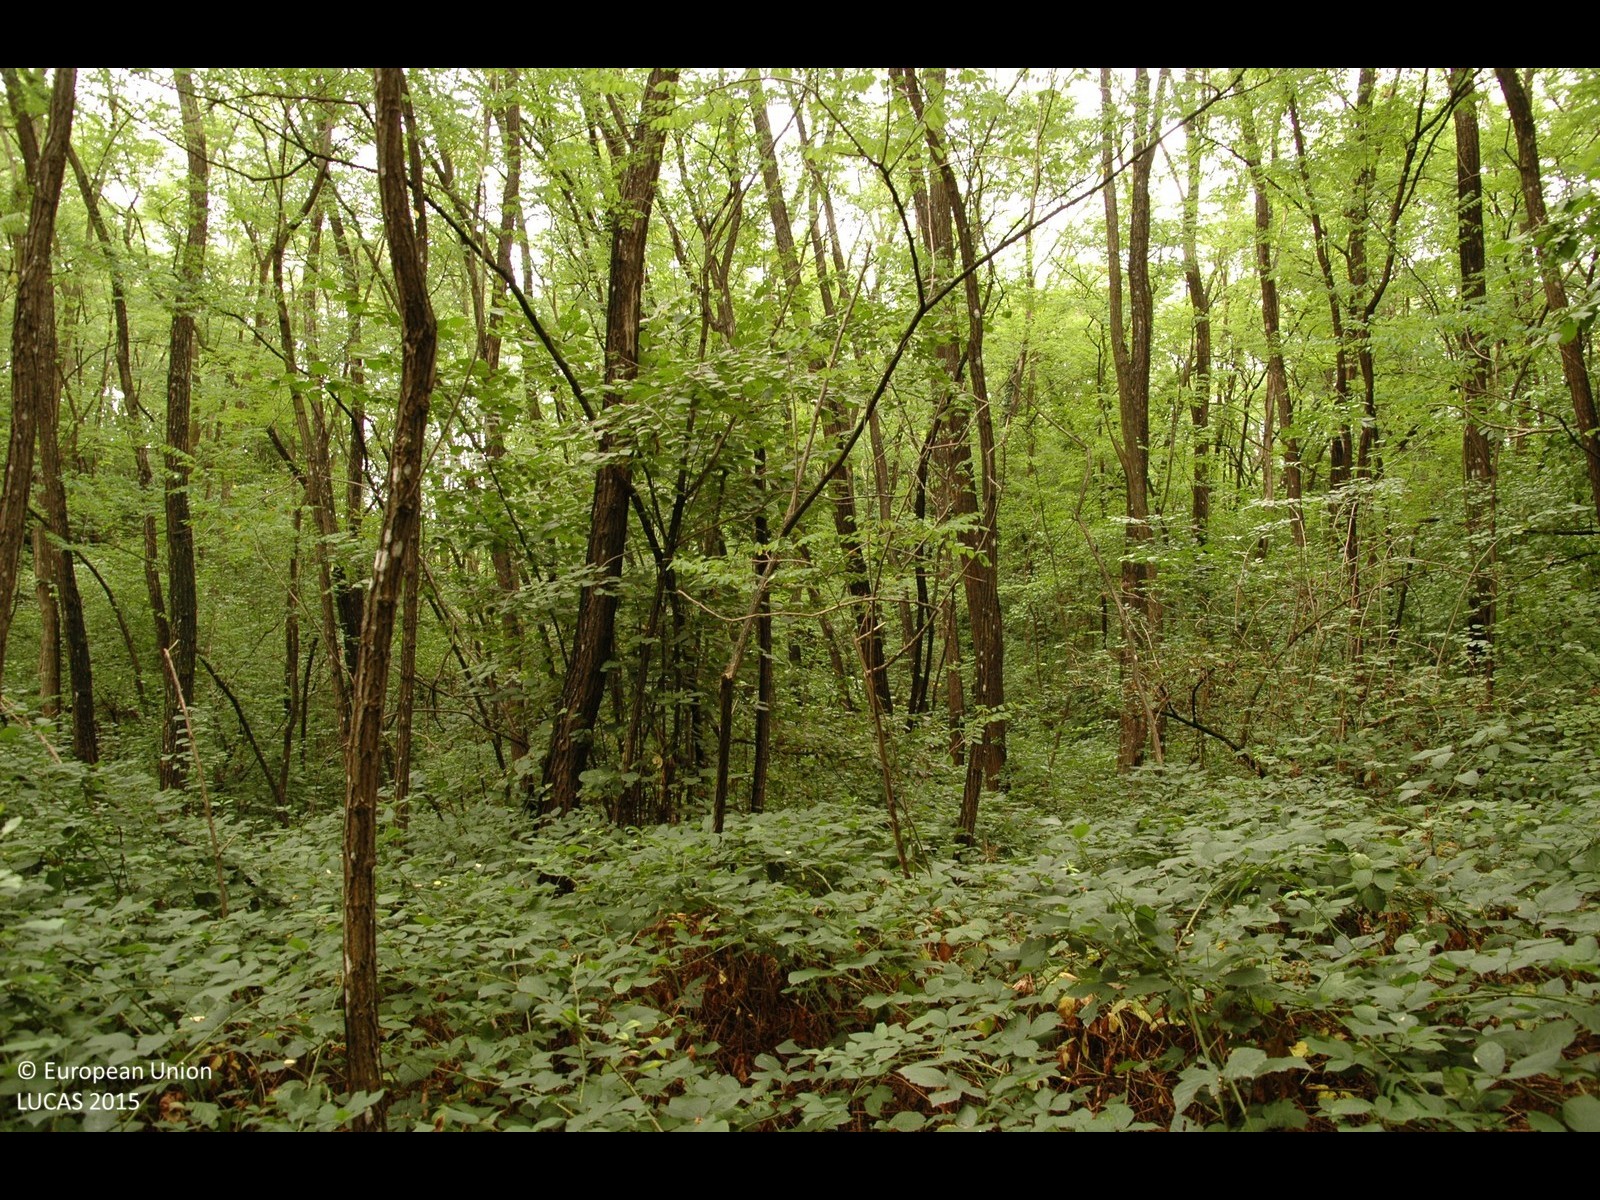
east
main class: Woodland
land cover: Broadleaved woodland
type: mesophytic deciduous forest
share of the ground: > 75 %
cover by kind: broadleaved forest trees 100 %
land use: Forestry
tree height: > 5 m
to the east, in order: Broadleaved woodland; Tracks; Broadleaved woodland; Ditches and canals; Broadleaved woodland
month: August
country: HR
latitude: 45.8690
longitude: 16.1173
